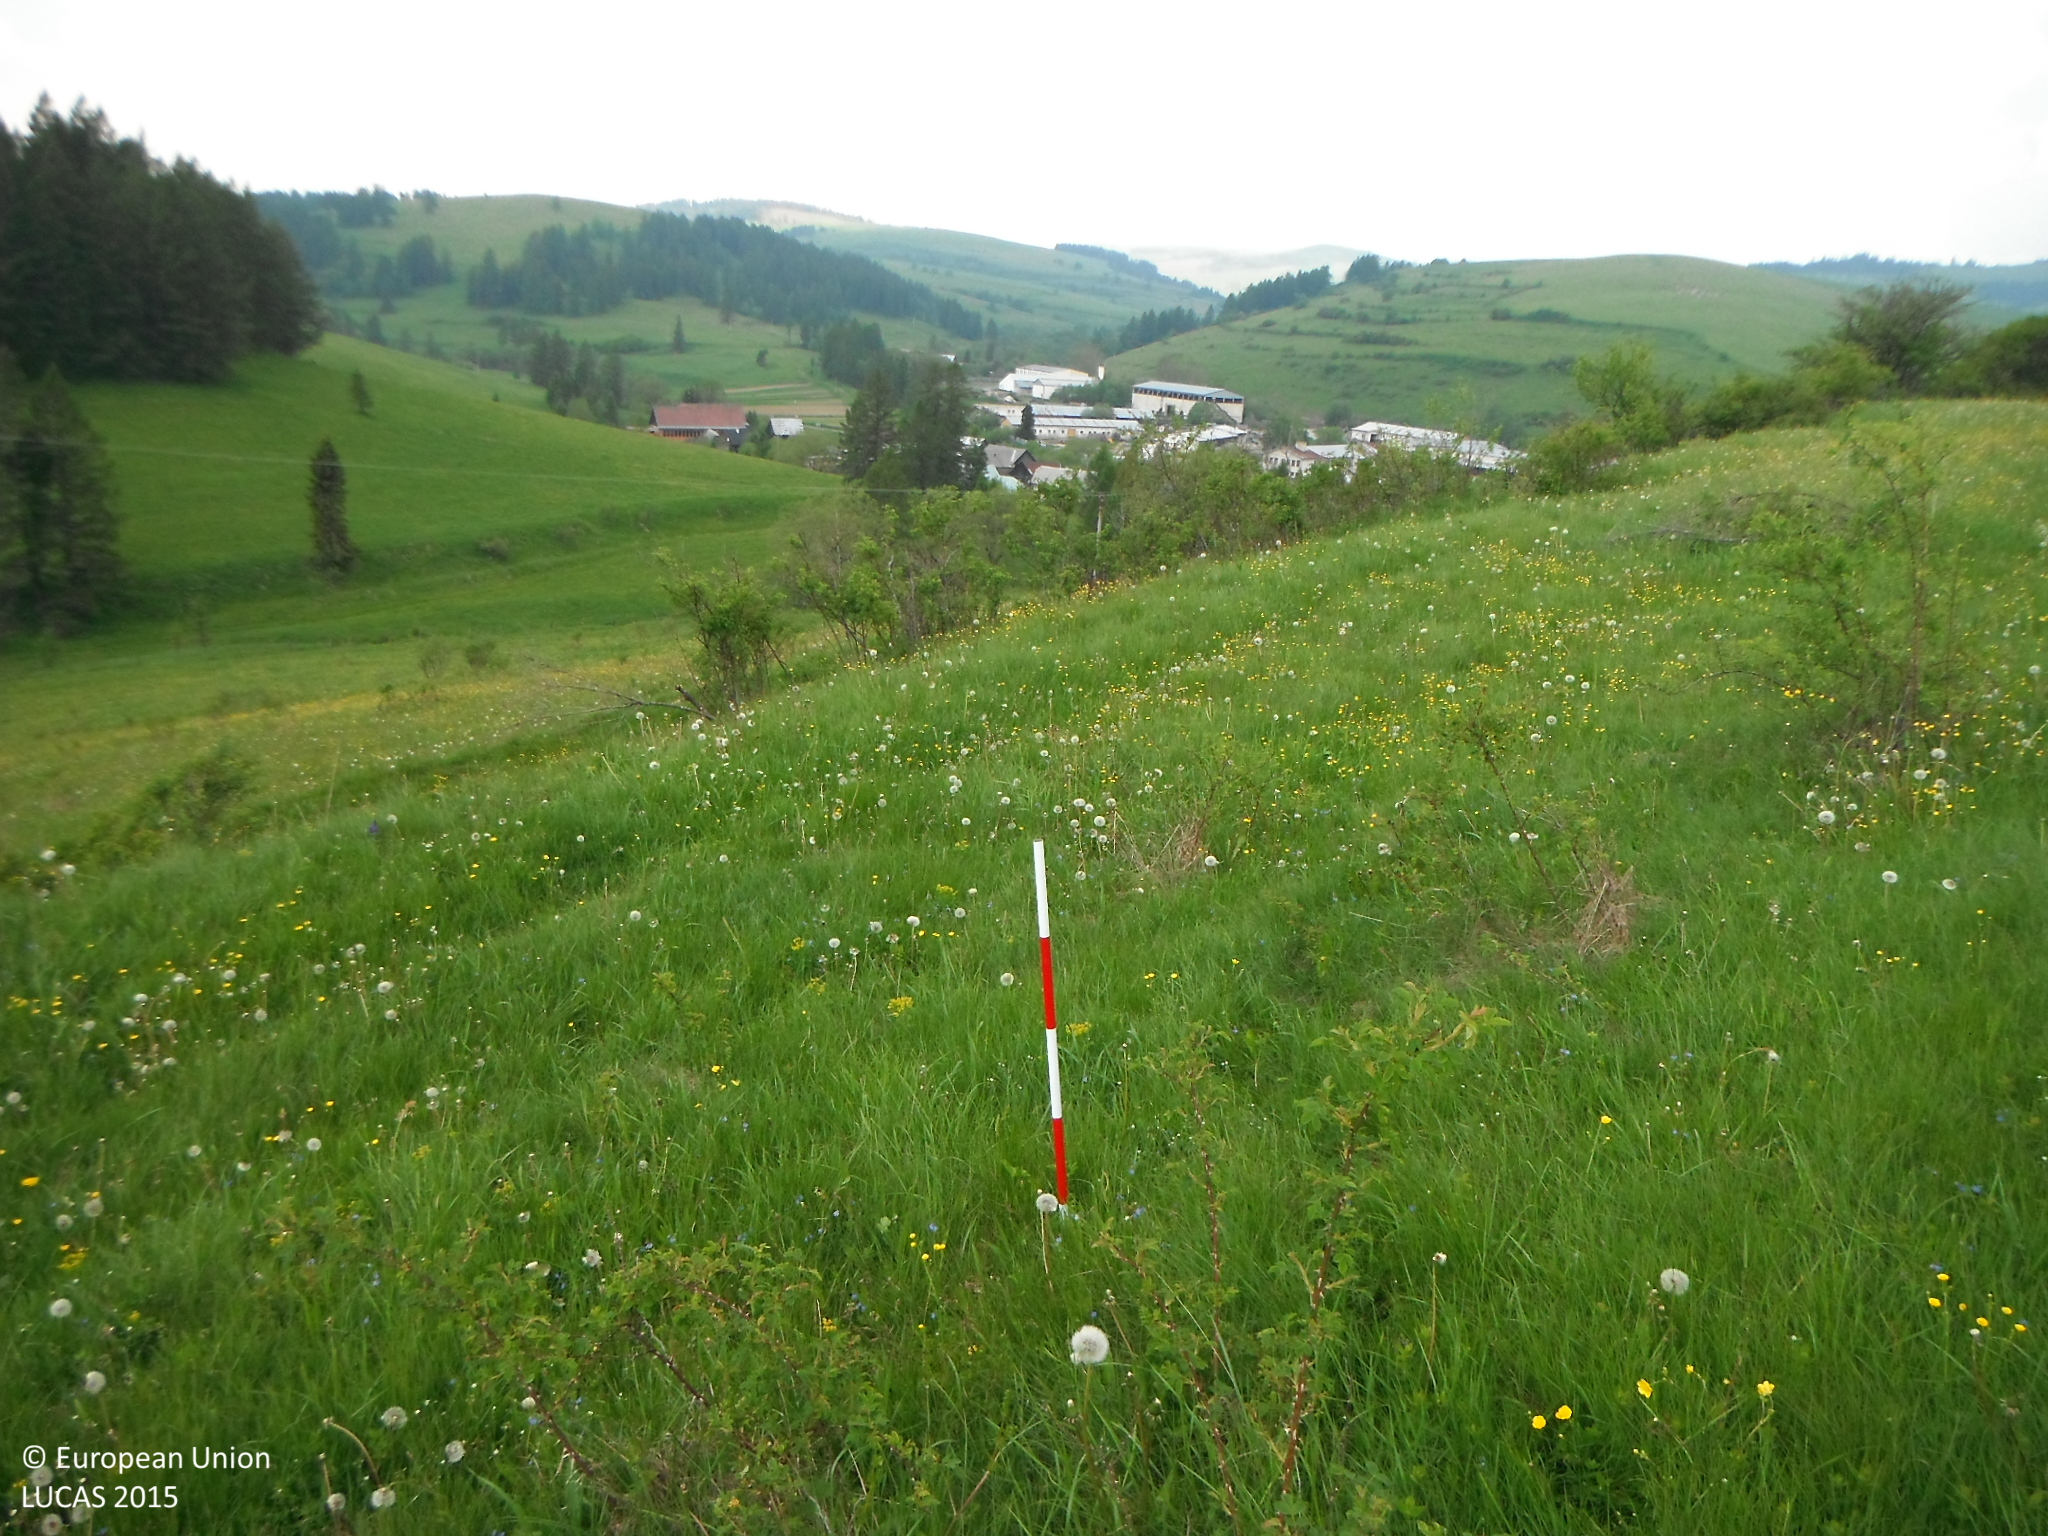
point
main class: Grassland
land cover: Grassland without tree/shrub cover
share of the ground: > 75 %
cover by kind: herbaceous plants 100 %
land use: Agriculture (excluding fallow land and kitchen gardens)
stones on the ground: < 10 %
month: June
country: SK
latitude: 49.0801
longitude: 20.7037
